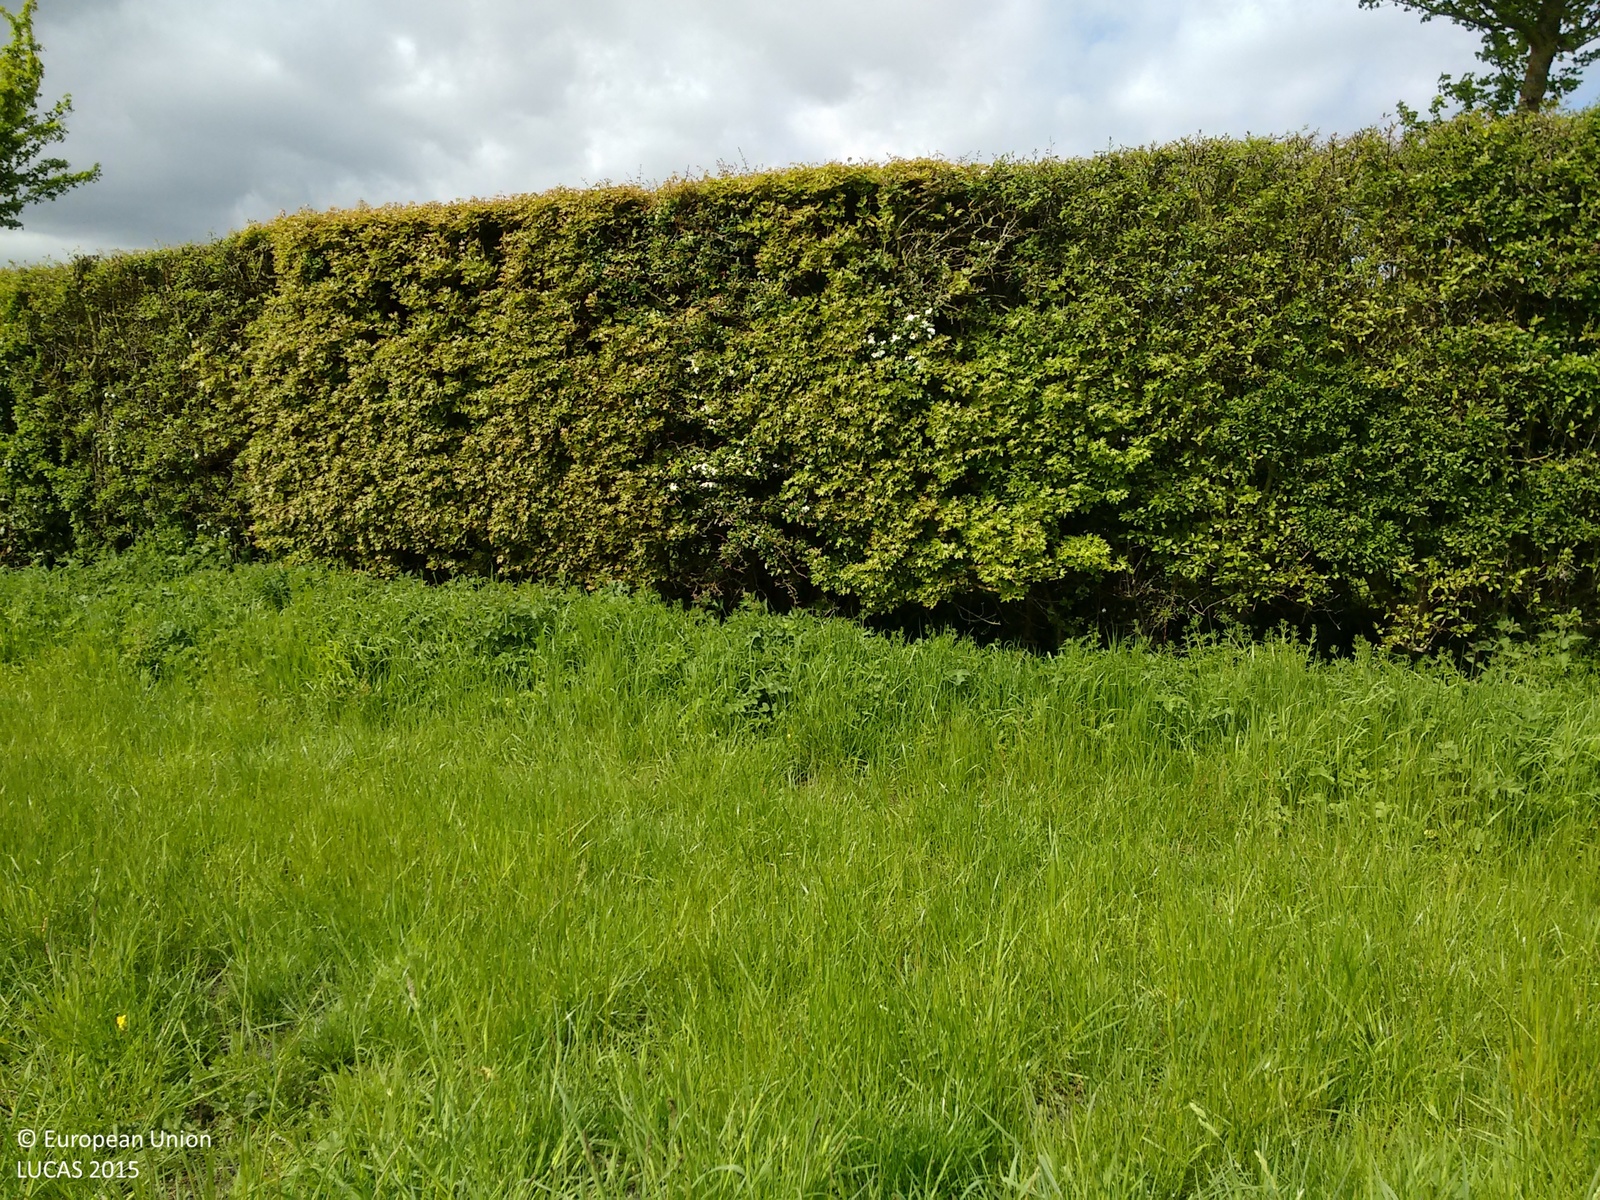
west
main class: Cropland
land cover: Common wheat
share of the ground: > 75 %
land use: Agriculture (excluding fallow land and kitchen gardens)
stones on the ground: < 10 %
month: May
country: GB
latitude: 51.3058
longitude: 0.2586
